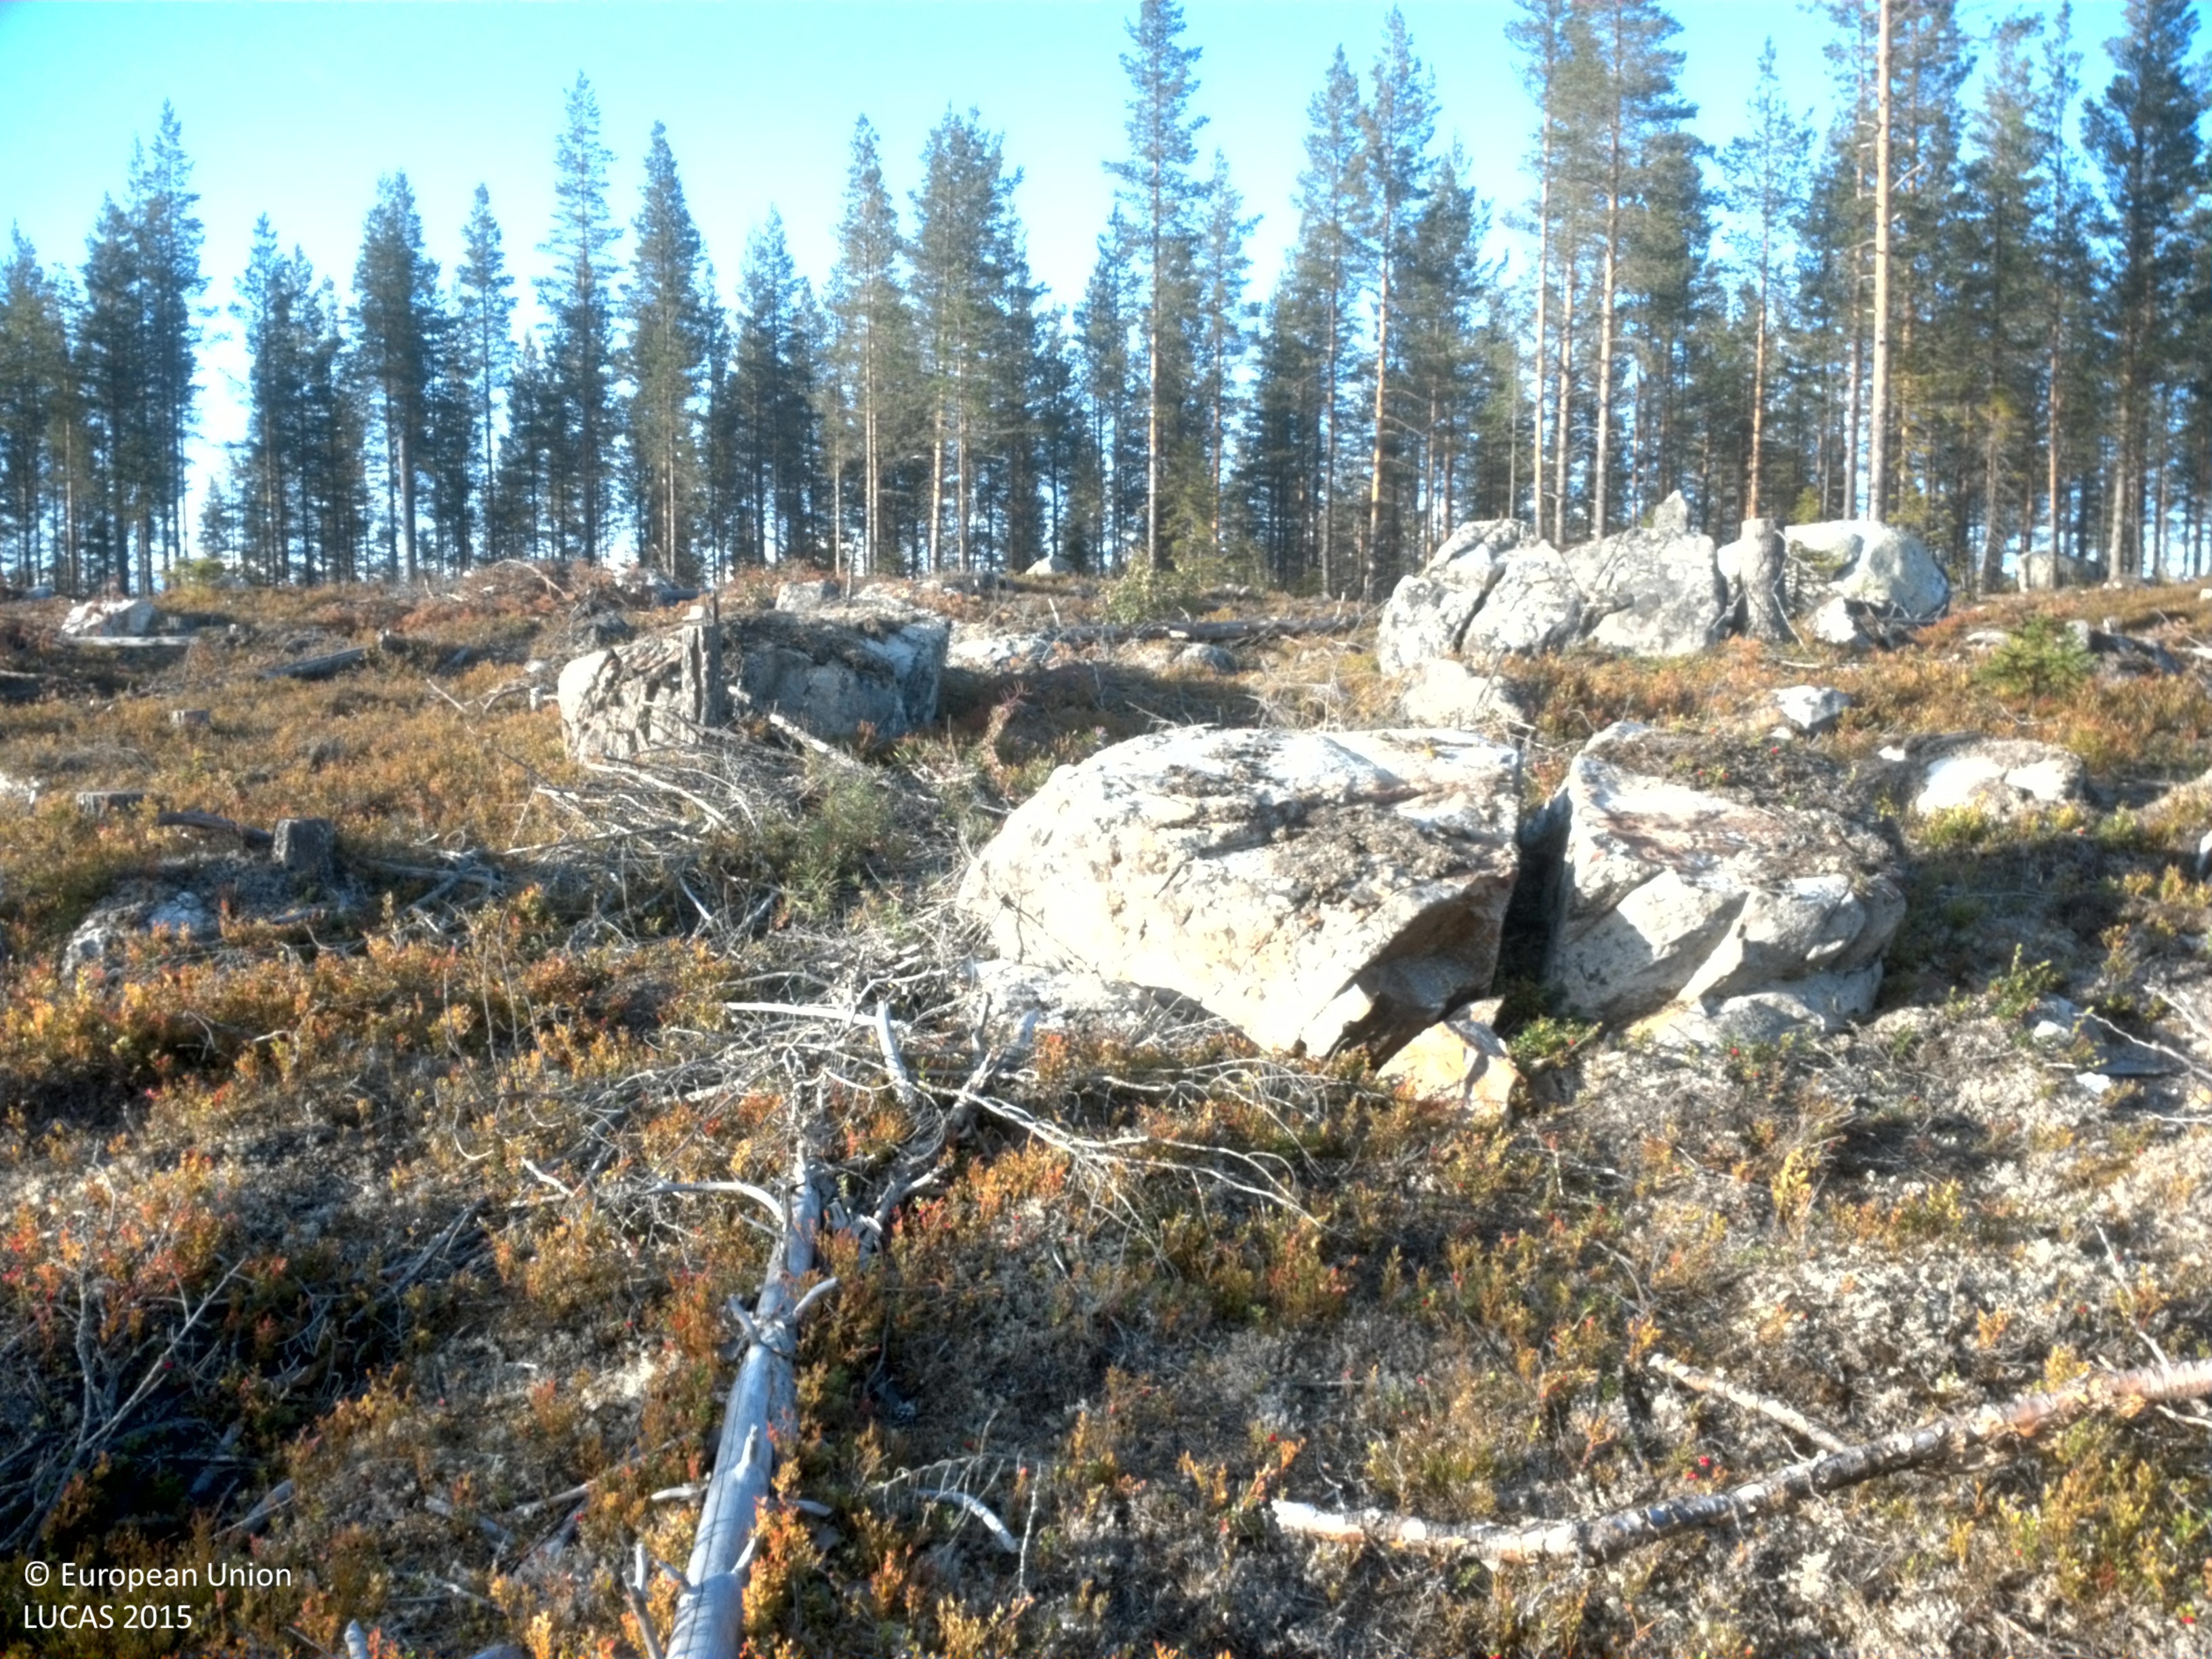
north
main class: Woodland
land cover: Pine dominated coniferous woodland
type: boreal forest
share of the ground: 10 - 25 %
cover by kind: shrubs 75 %, lichens and mosses 15 %, coniferous forest trees 10 %
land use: Forestry
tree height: > 5 m
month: September
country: SE
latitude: 64.4458
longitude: 19.7177
